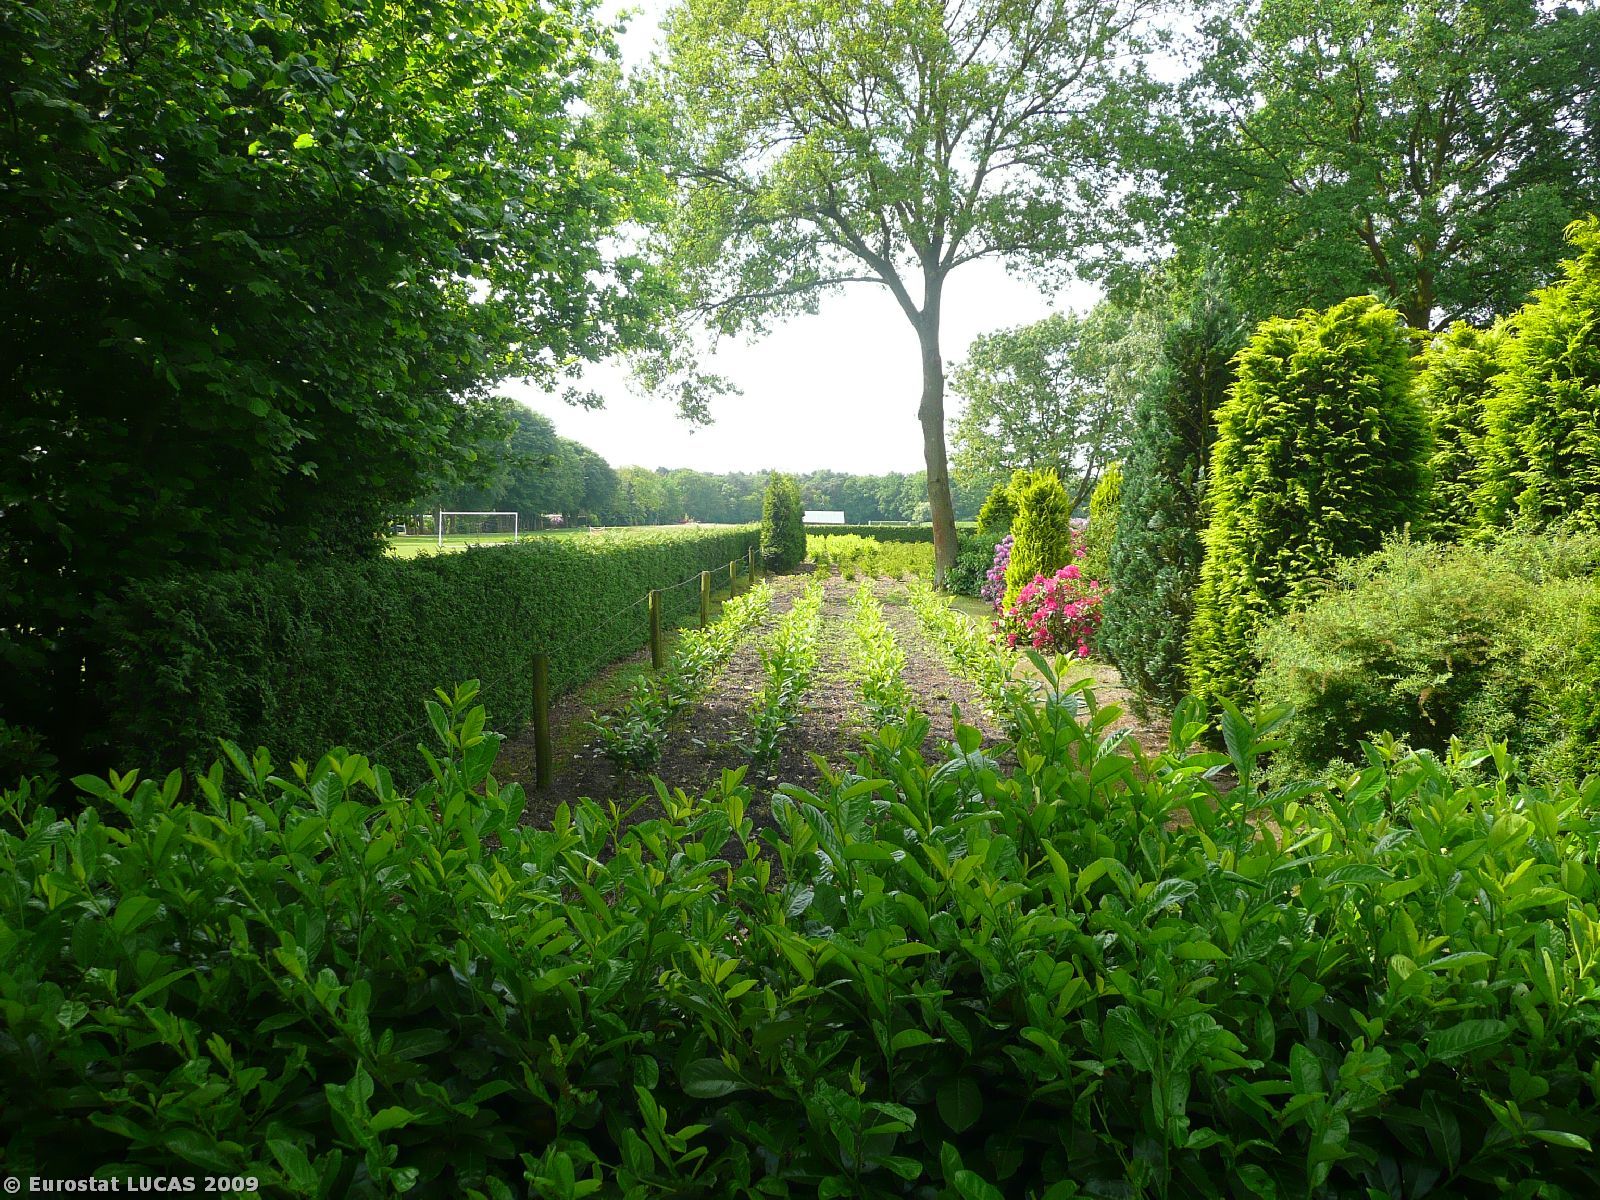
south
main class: Woodland
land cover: Coniferous woodland
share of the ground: > 75 %
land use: Residential
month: May
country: NL
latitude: 52.1598
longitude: 5.3349
